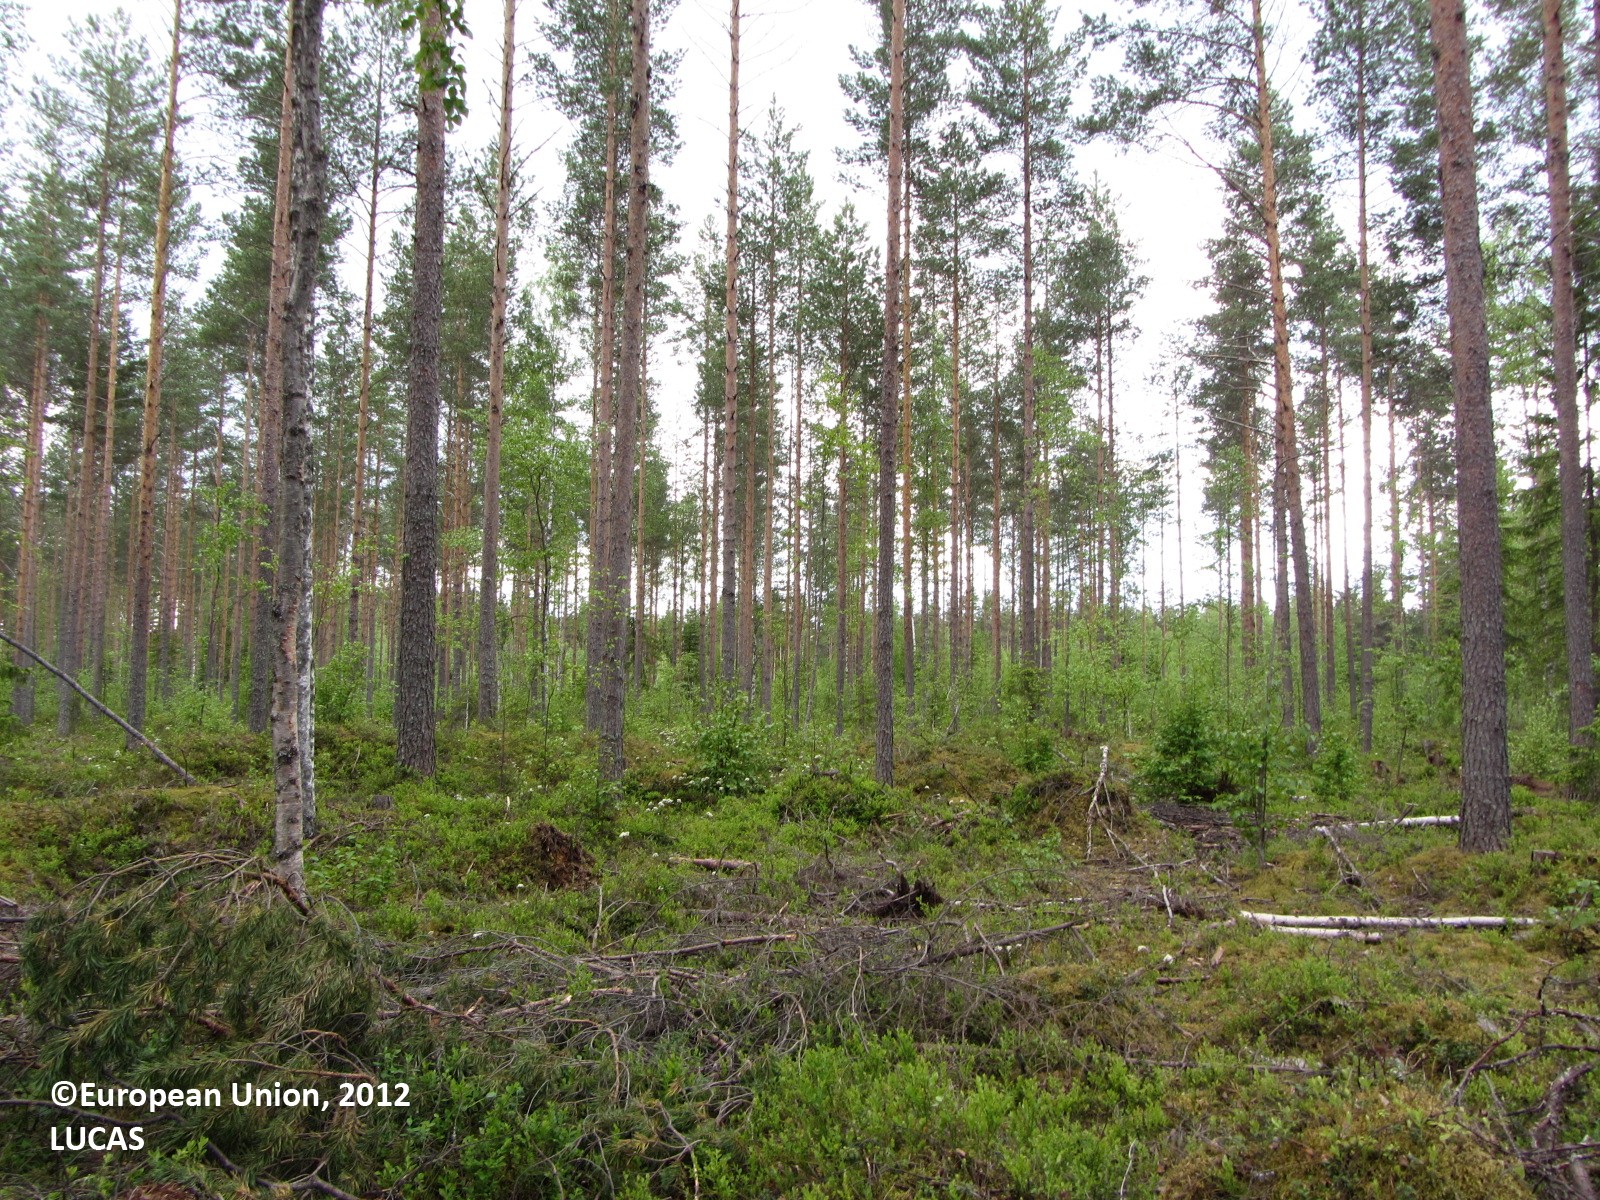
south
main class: Woodland
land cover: Pine dominated mixed woodland
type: boreal forest
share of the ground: 50 - 75 %
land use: Forestry
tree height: > 5 m
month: June
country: FI
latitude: 61.9361
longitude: 25.1033
